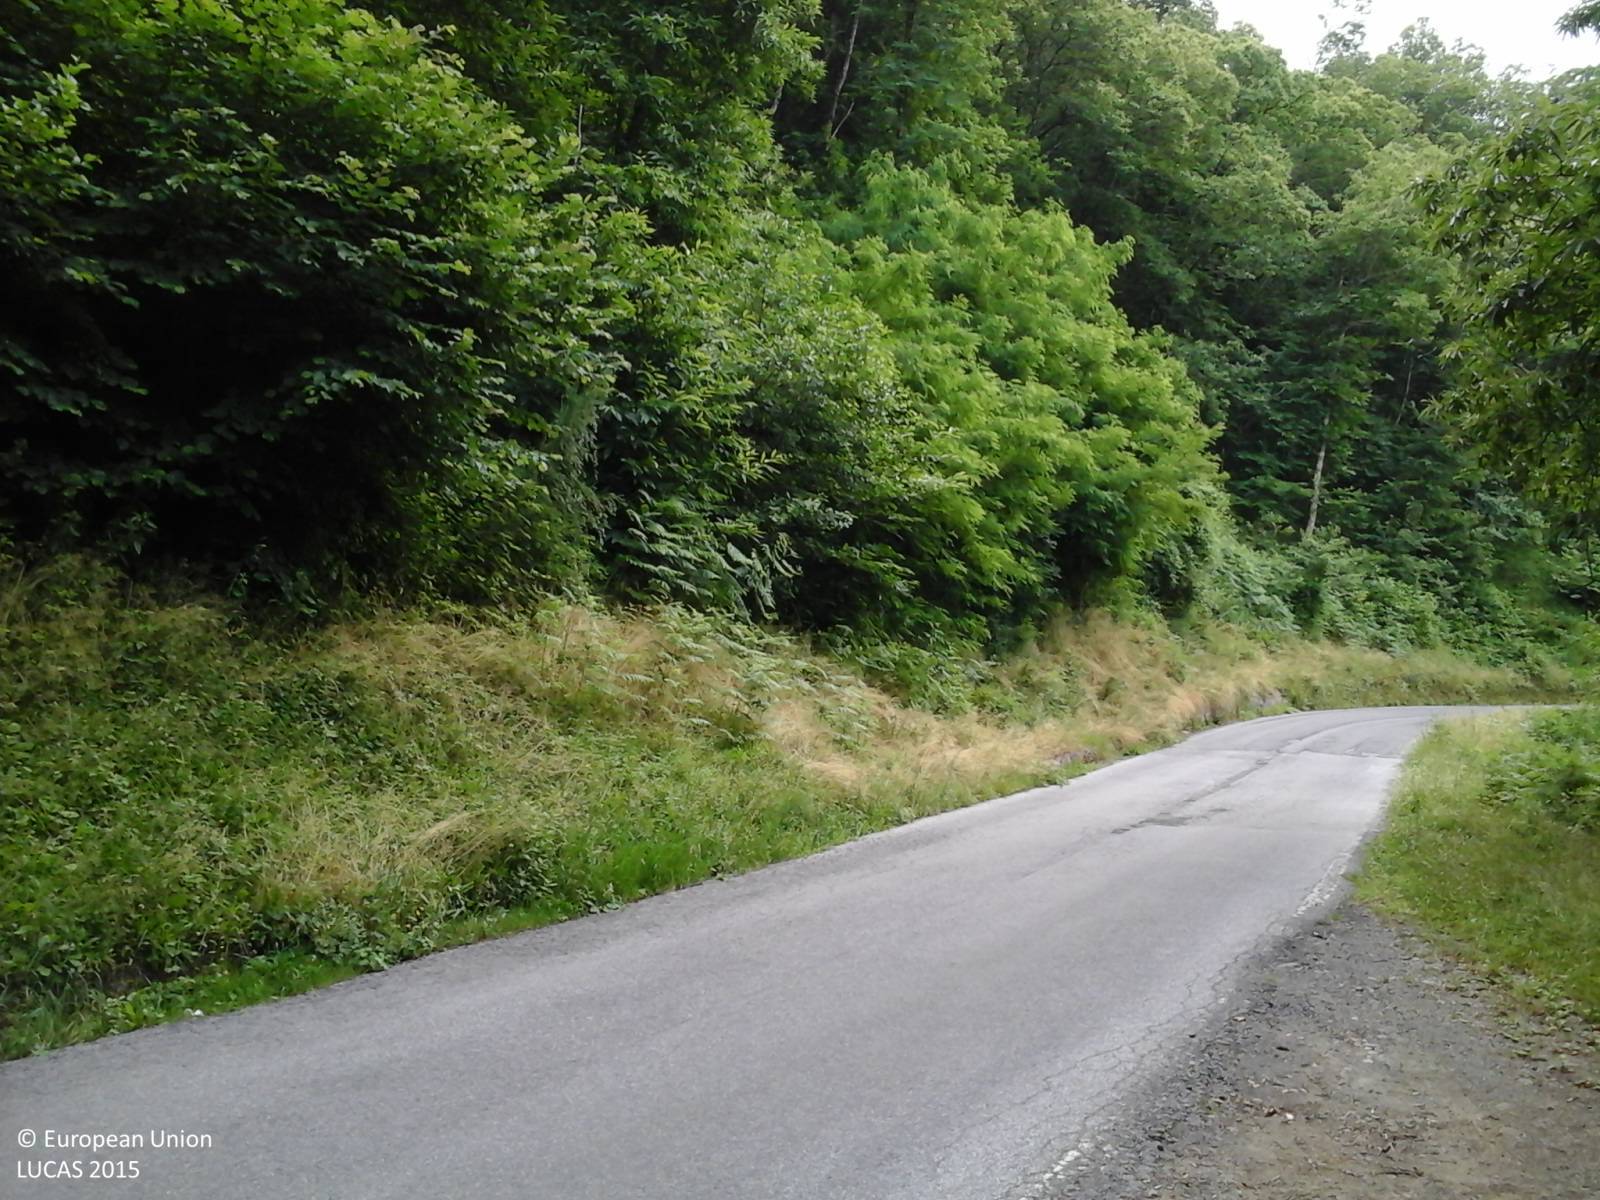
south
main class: Woodland
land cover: Broadleaved woodland
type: thermophilous deciduous forest
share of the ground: > 75 %
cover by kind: broadleaved forest trees 100 %
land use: Forestry
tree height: > 5 m
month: June
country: IT
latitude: 44.1335
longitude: 10.3367
